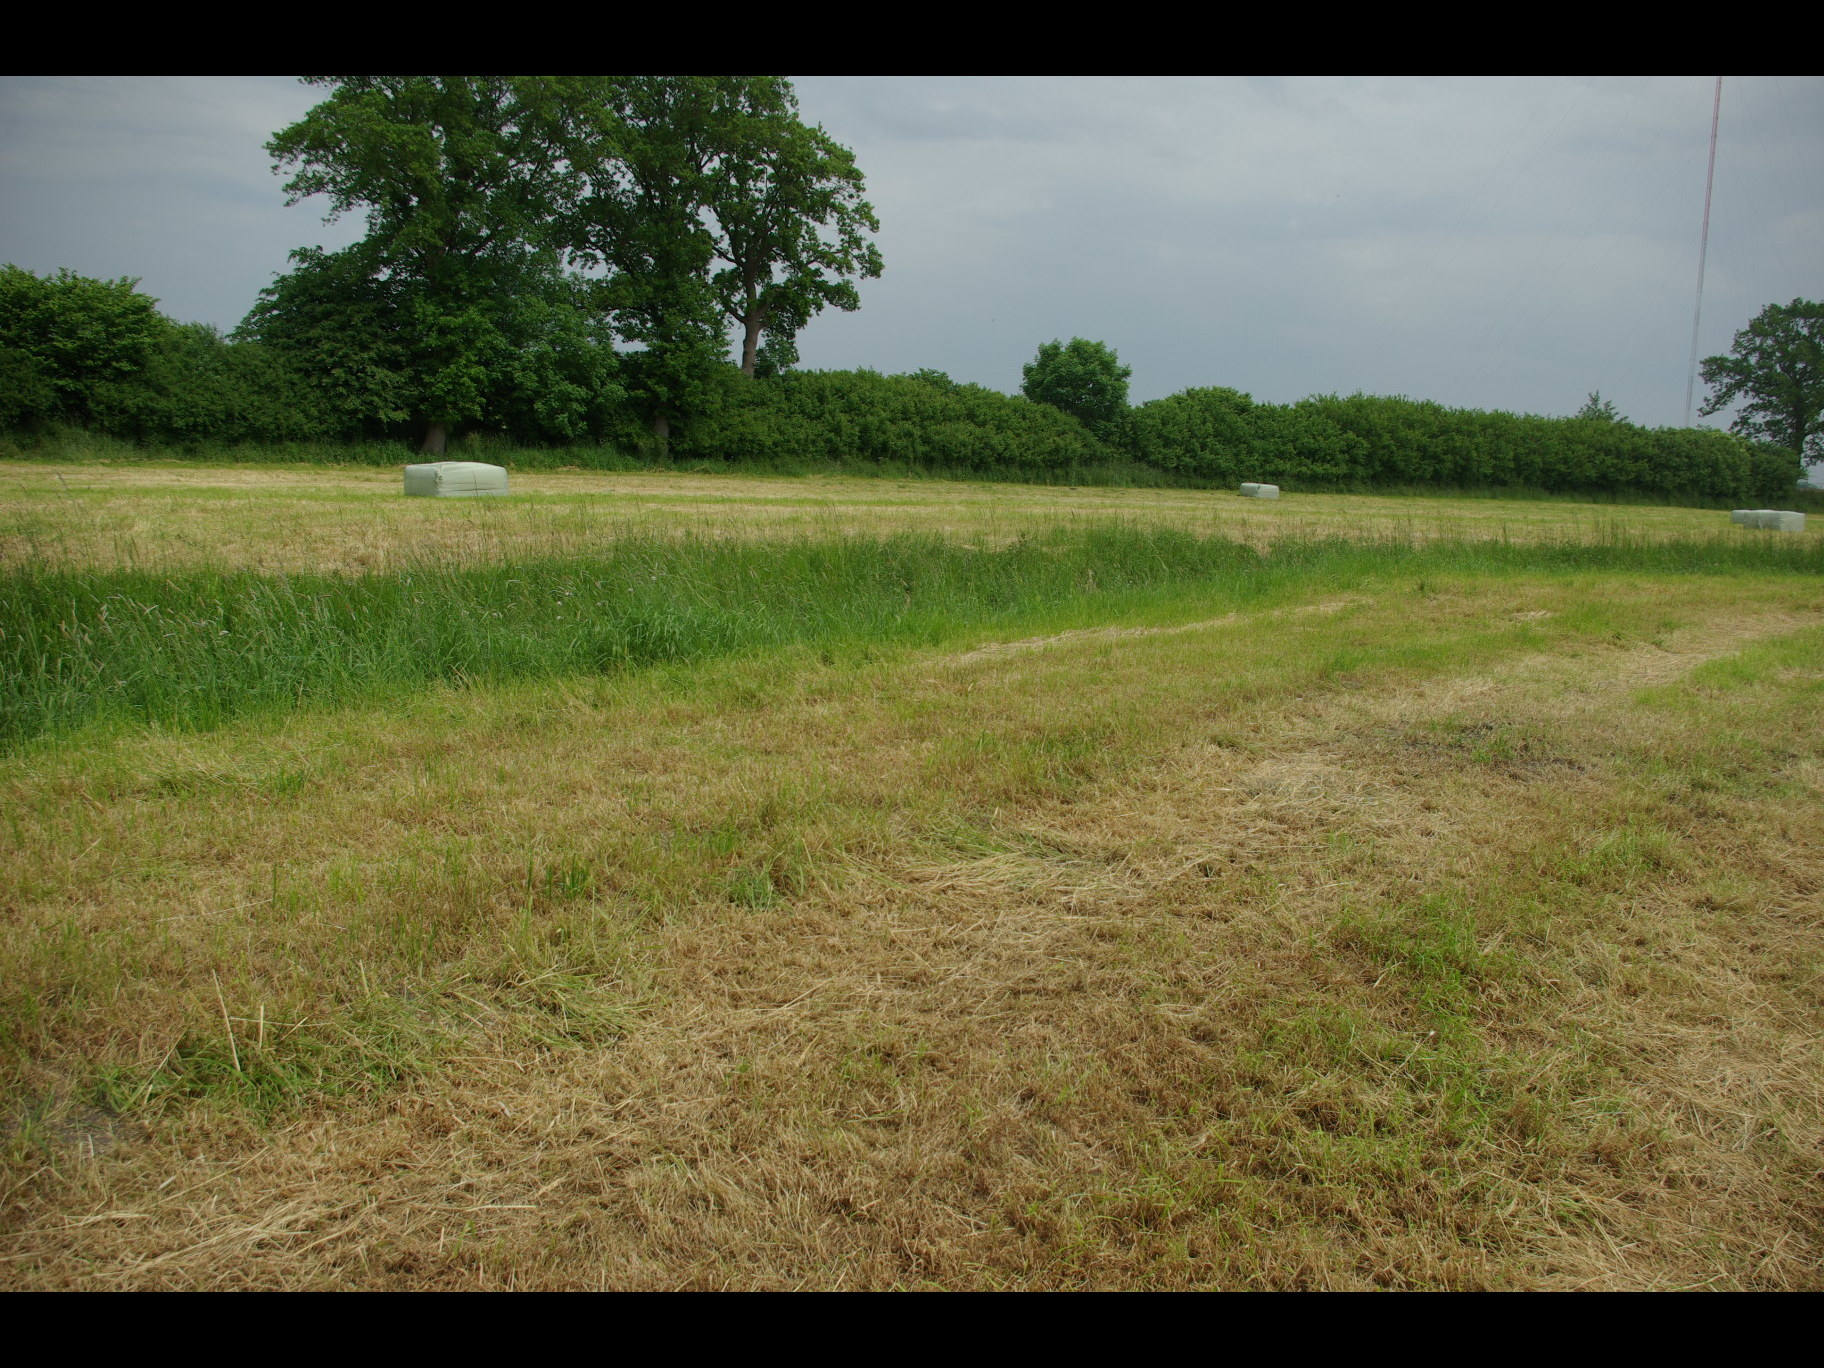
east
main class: Grassland
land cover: Grassland without tree/shrub cover
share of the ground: > 75 %
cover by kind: herbaceous plants 100 %
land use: Agriculture (excluding fallow land and kitchen gardens)
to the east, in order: Grassland without tree/shrub cover; Rivers and streams; Grassland without tree/shrub cover; Shruby margins; Shrubland with sparse tree cover; Ditches and canals; Shrubland with sparse tree cover; Grassland without tree/shrub cover; Other bare soil
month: June
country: DE
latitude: 54.4083
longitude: 9.8922
